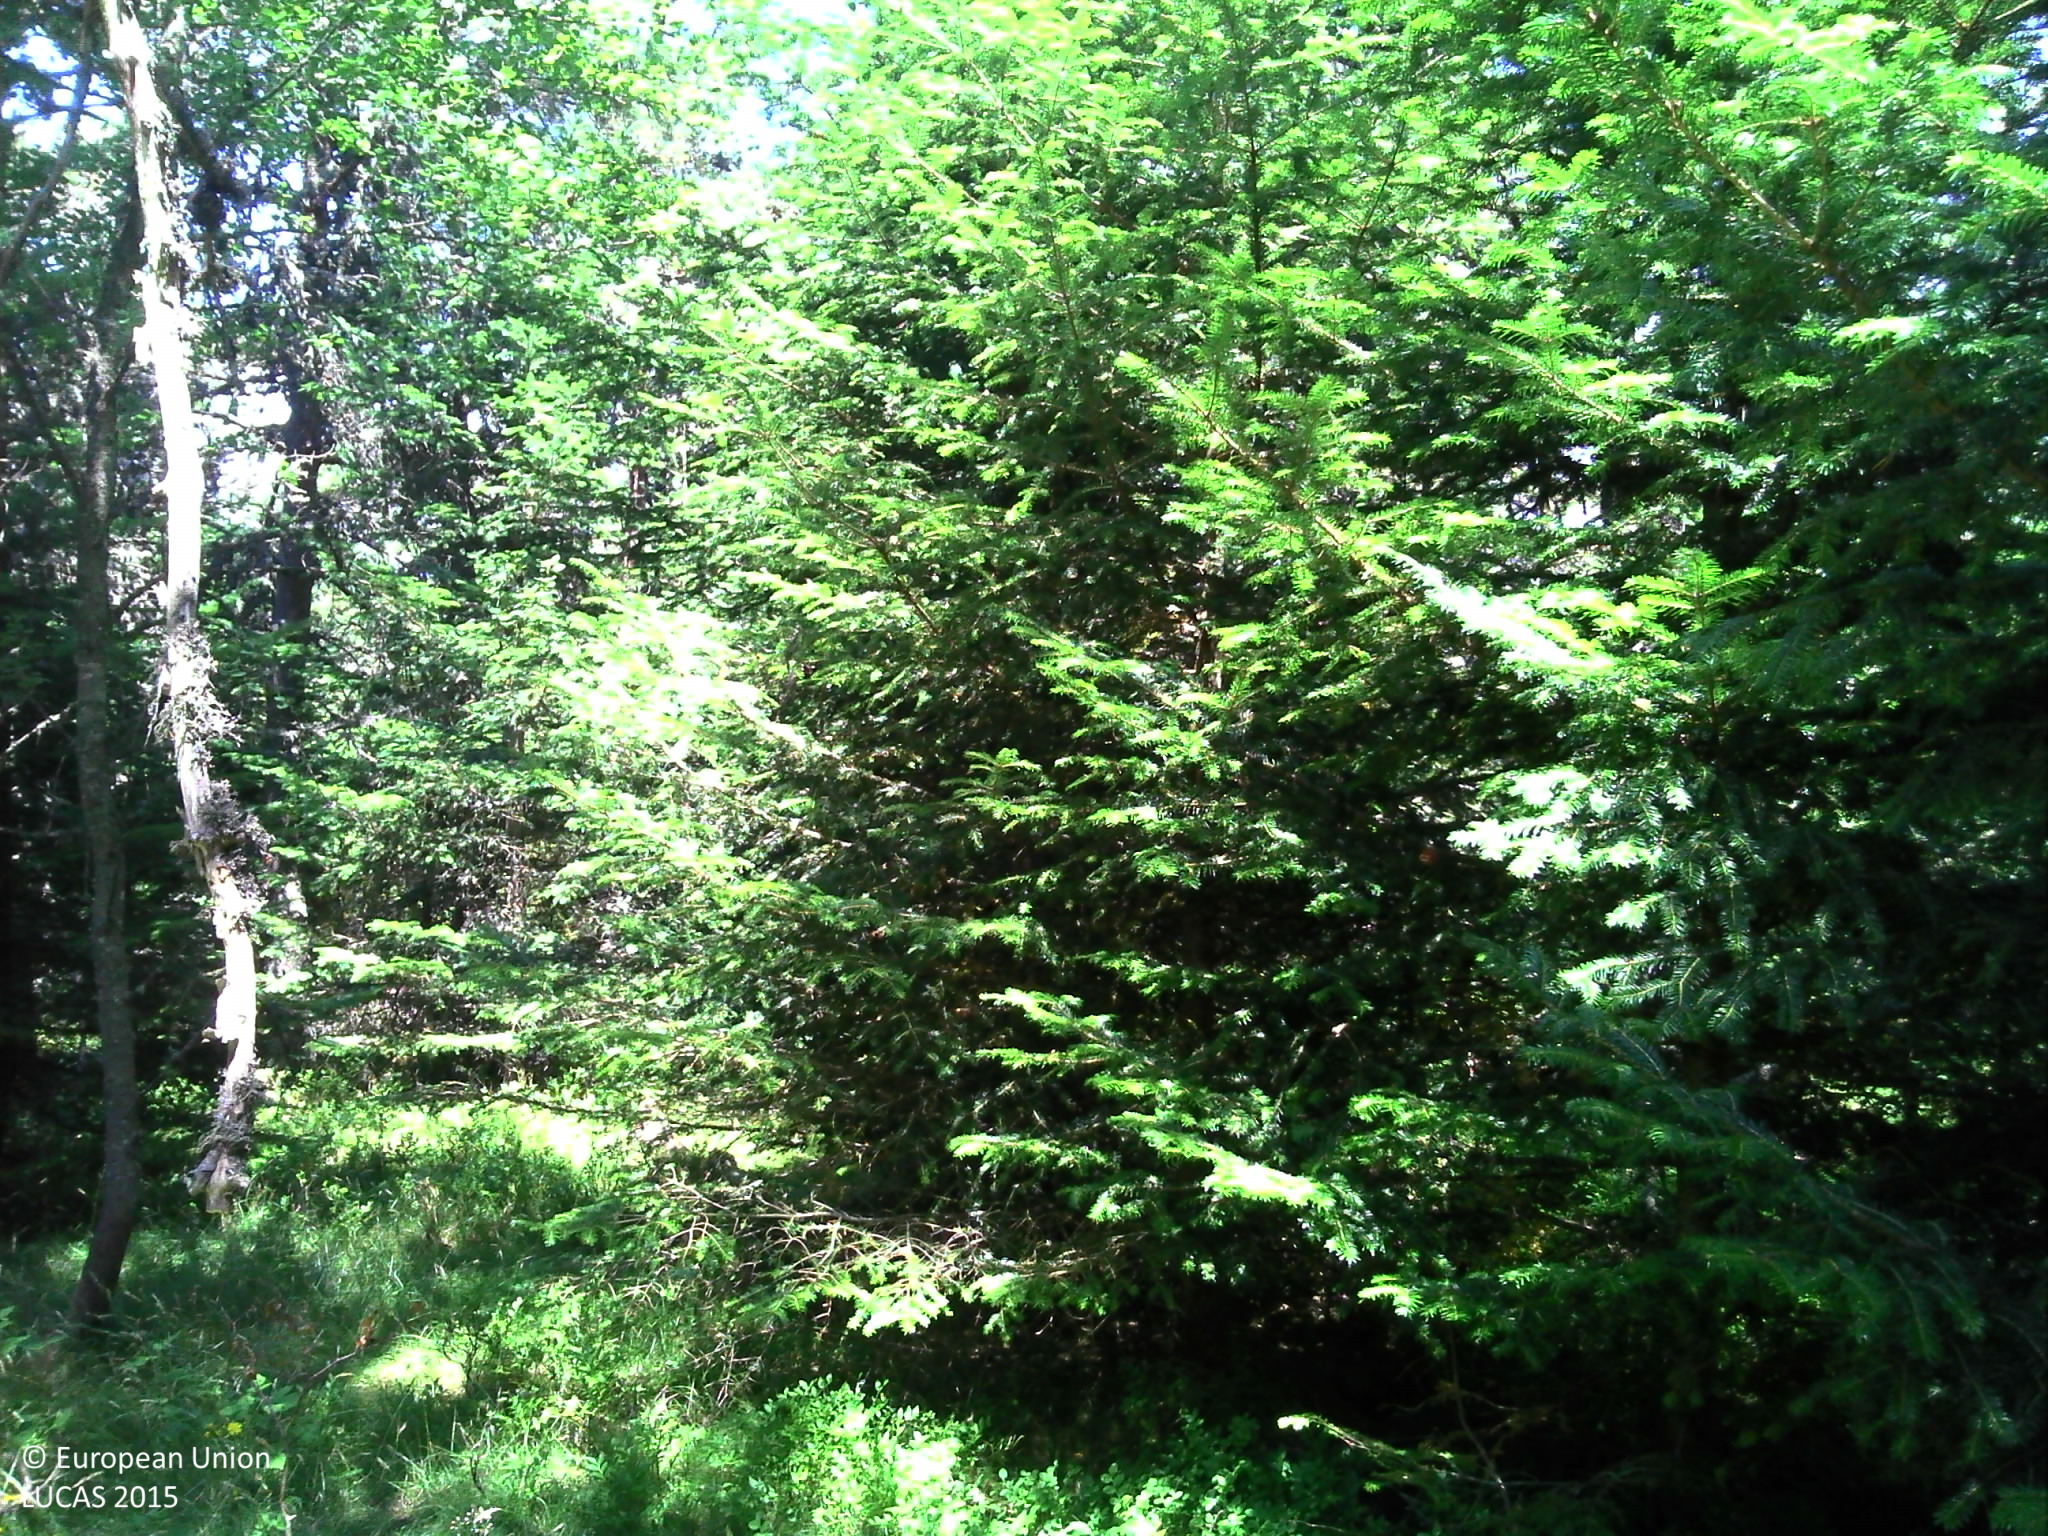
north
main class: Woodland
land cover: Spruce dominated coniferous woodland
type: exotic forest
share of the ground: > 75 %
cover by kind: coniferous forest trees 80 %, shrubs 10 %, herbaceous plants 10 %
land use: Forestry
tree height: > 5 m
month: July
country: FR
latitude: 44.9020
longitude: 3.4309
